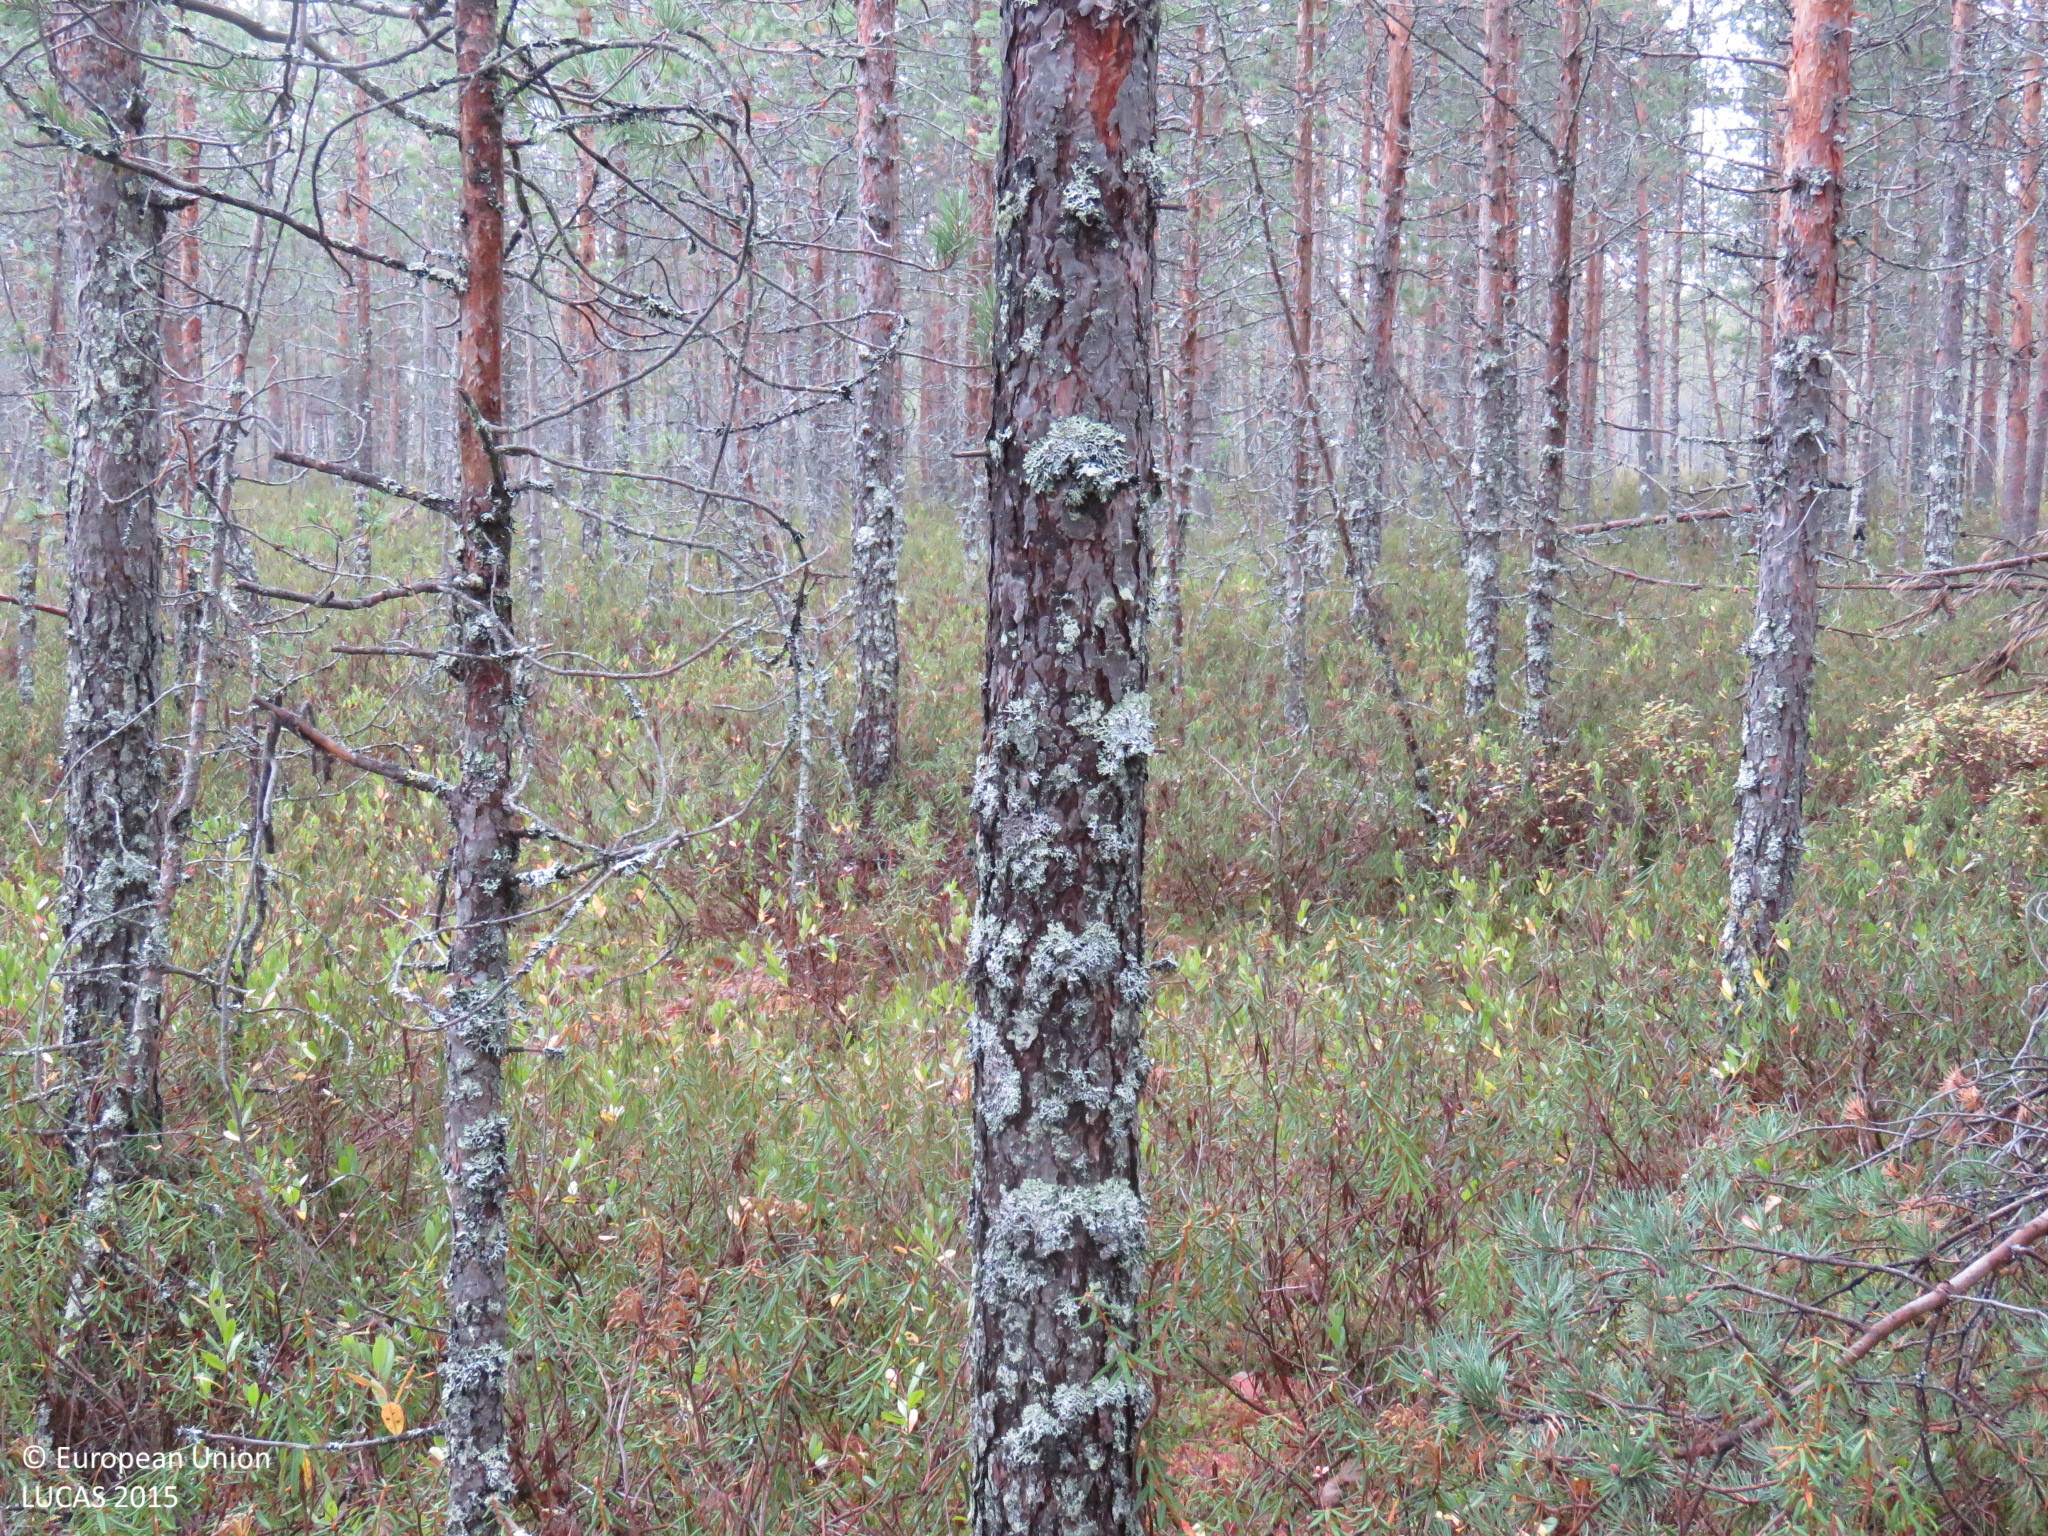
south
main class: Woodland
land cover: Pine dominated coniferous woodland
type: mire and swamp forests
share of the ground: > 75 %
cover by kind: coniferous forest trees 70 %, shrubs 15 %, lichens and mosses 10 %, broadleaved forest trees 5 %
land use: Forestry
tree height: > 5 m
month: September
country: FI
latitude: 65.2358
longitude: 27.1756
